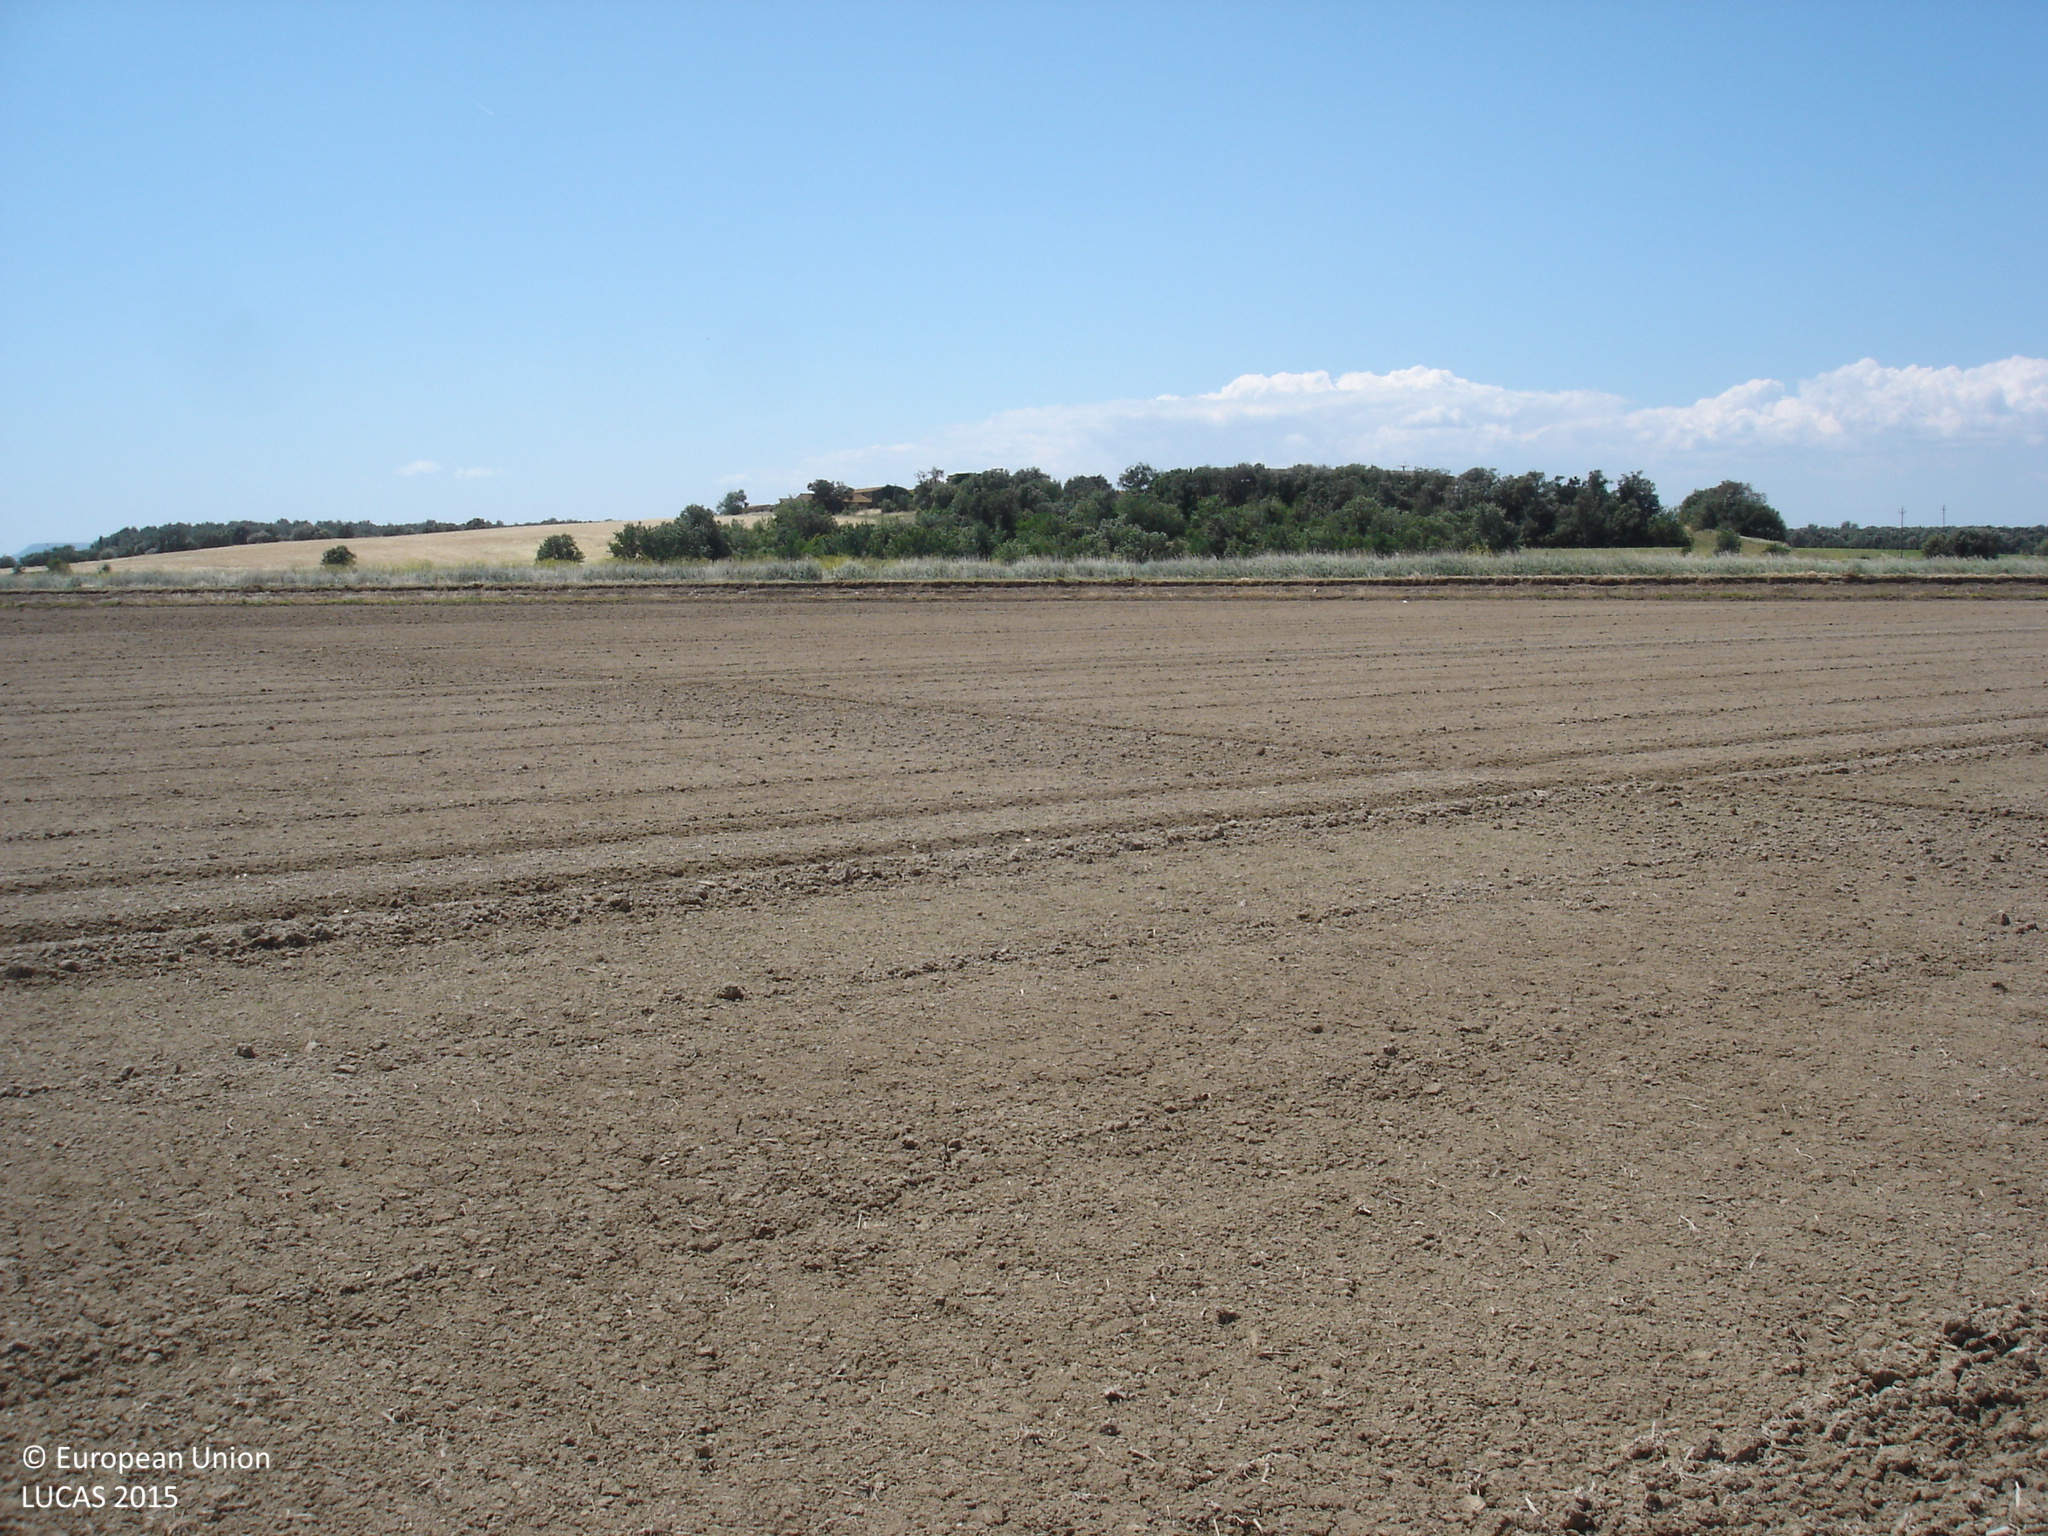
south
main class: Cropland
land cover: Rice
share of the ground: < 10 %
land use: Agriculture (excluding fallow land and kitchen gardens)
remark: Tilled/Sowed
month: May
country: ES
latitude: 42.2157
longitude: 3.0492
